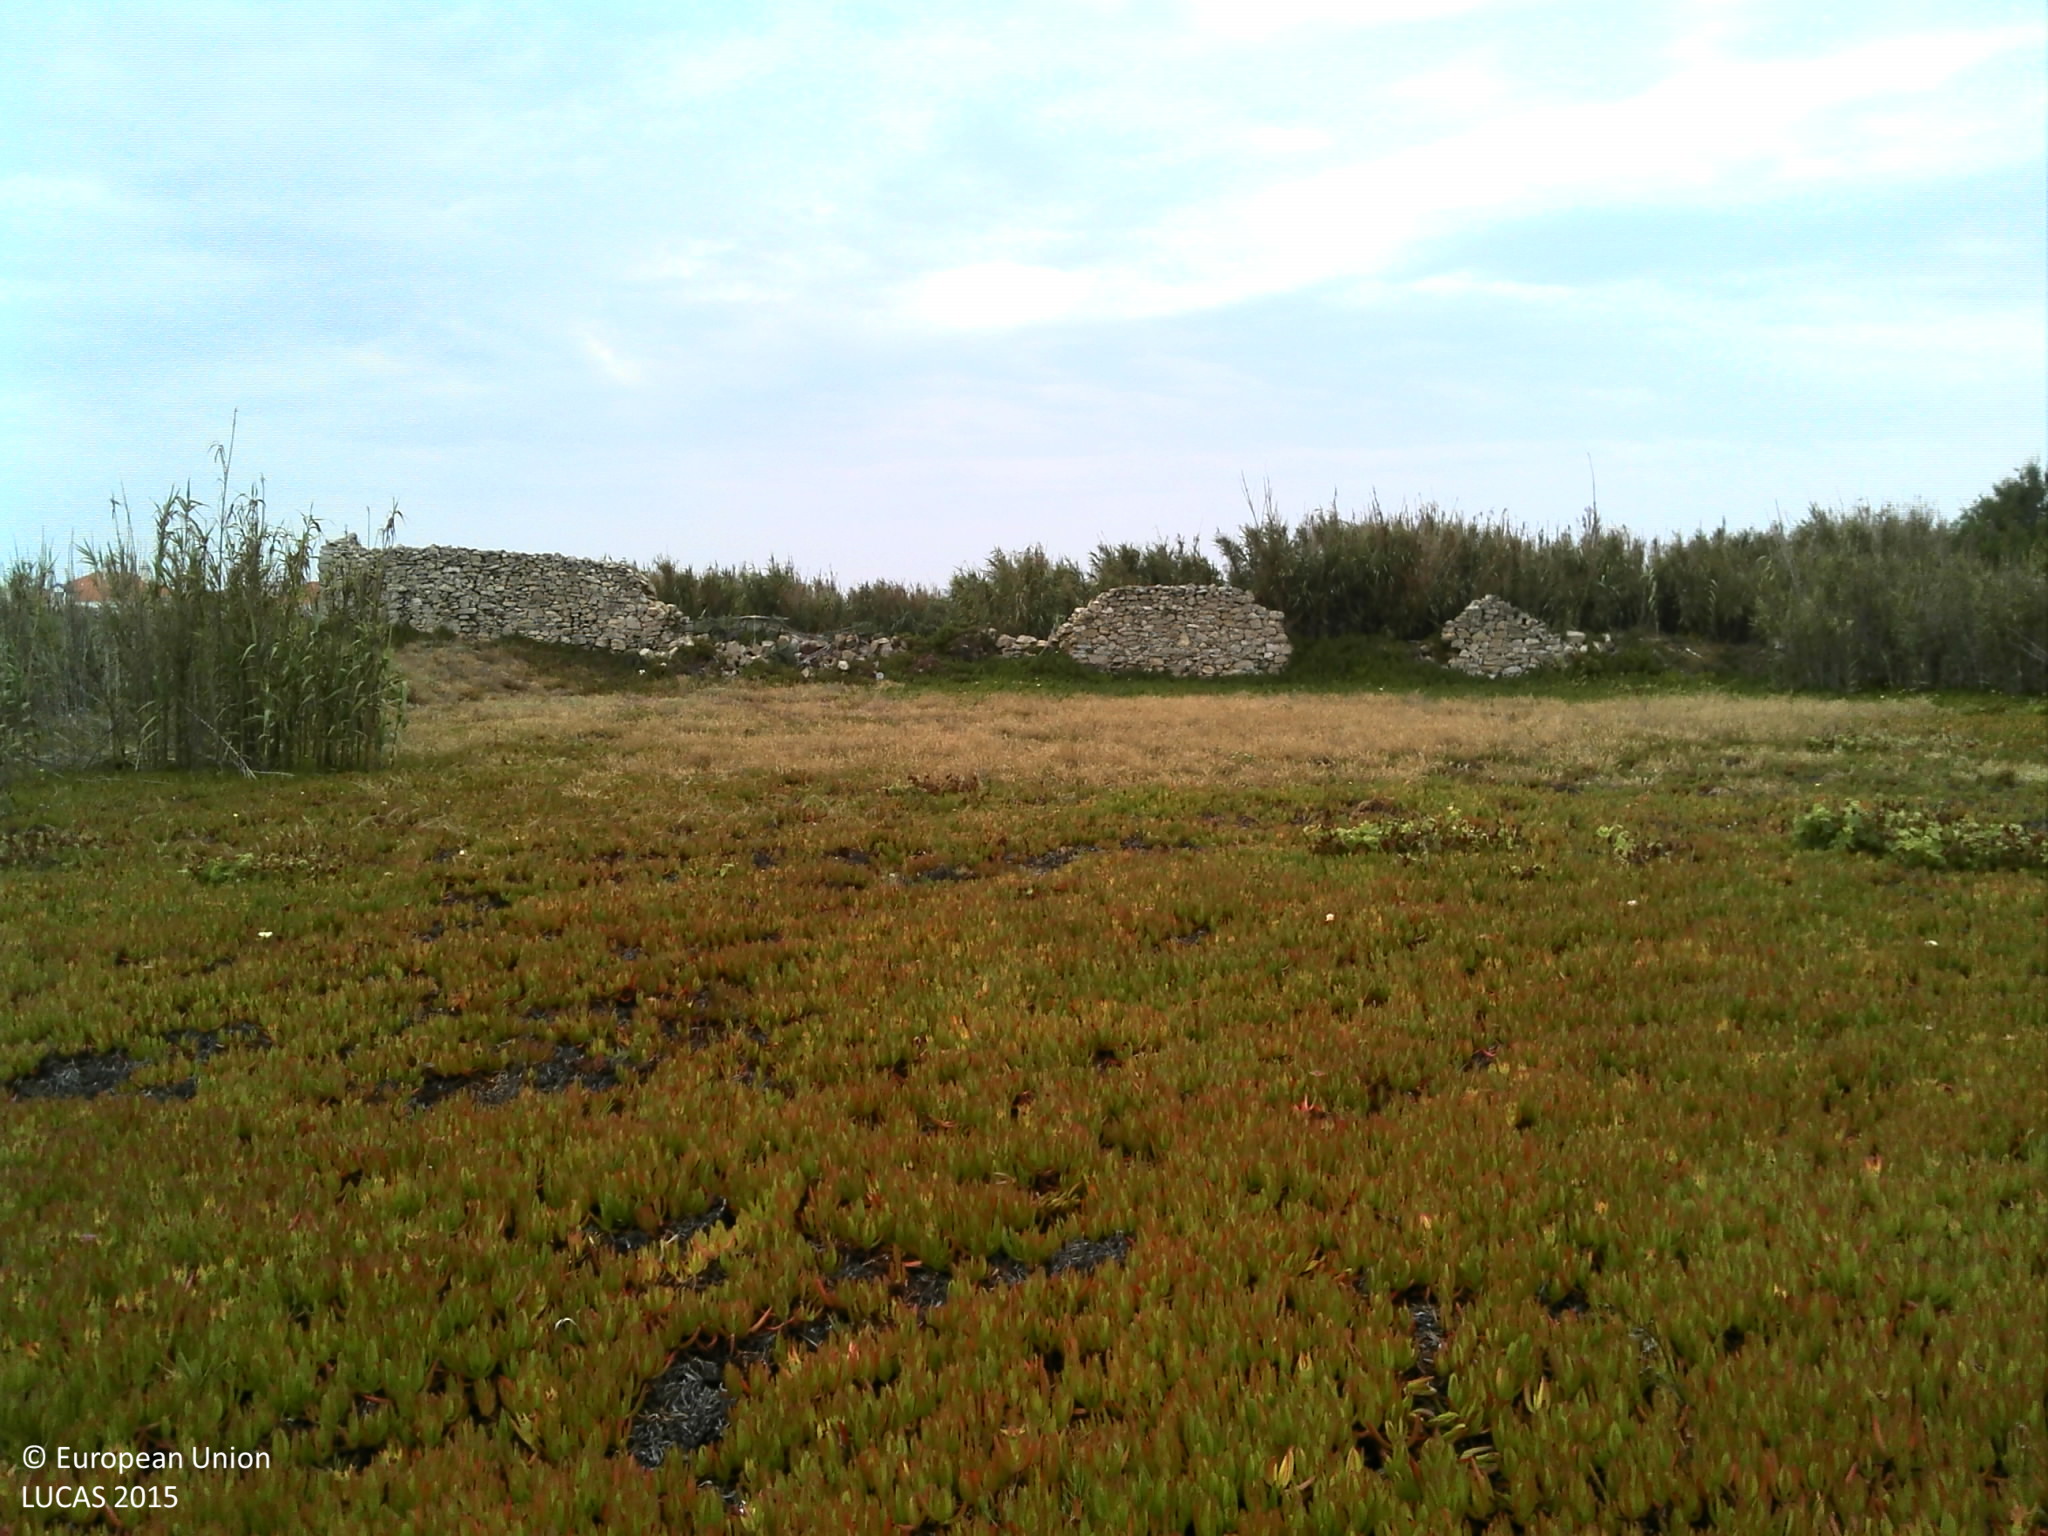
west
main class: Shrubland
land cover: Shrubland without tree cover
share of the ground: 50 - 75 %
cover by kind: shrubs 75 %, herbaceous plants 15 %, unconsolidated bare surface 10 %
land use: Semi-natural and natural areas not in use
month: June
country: PT
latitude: 39.3671
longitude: -9.3983
